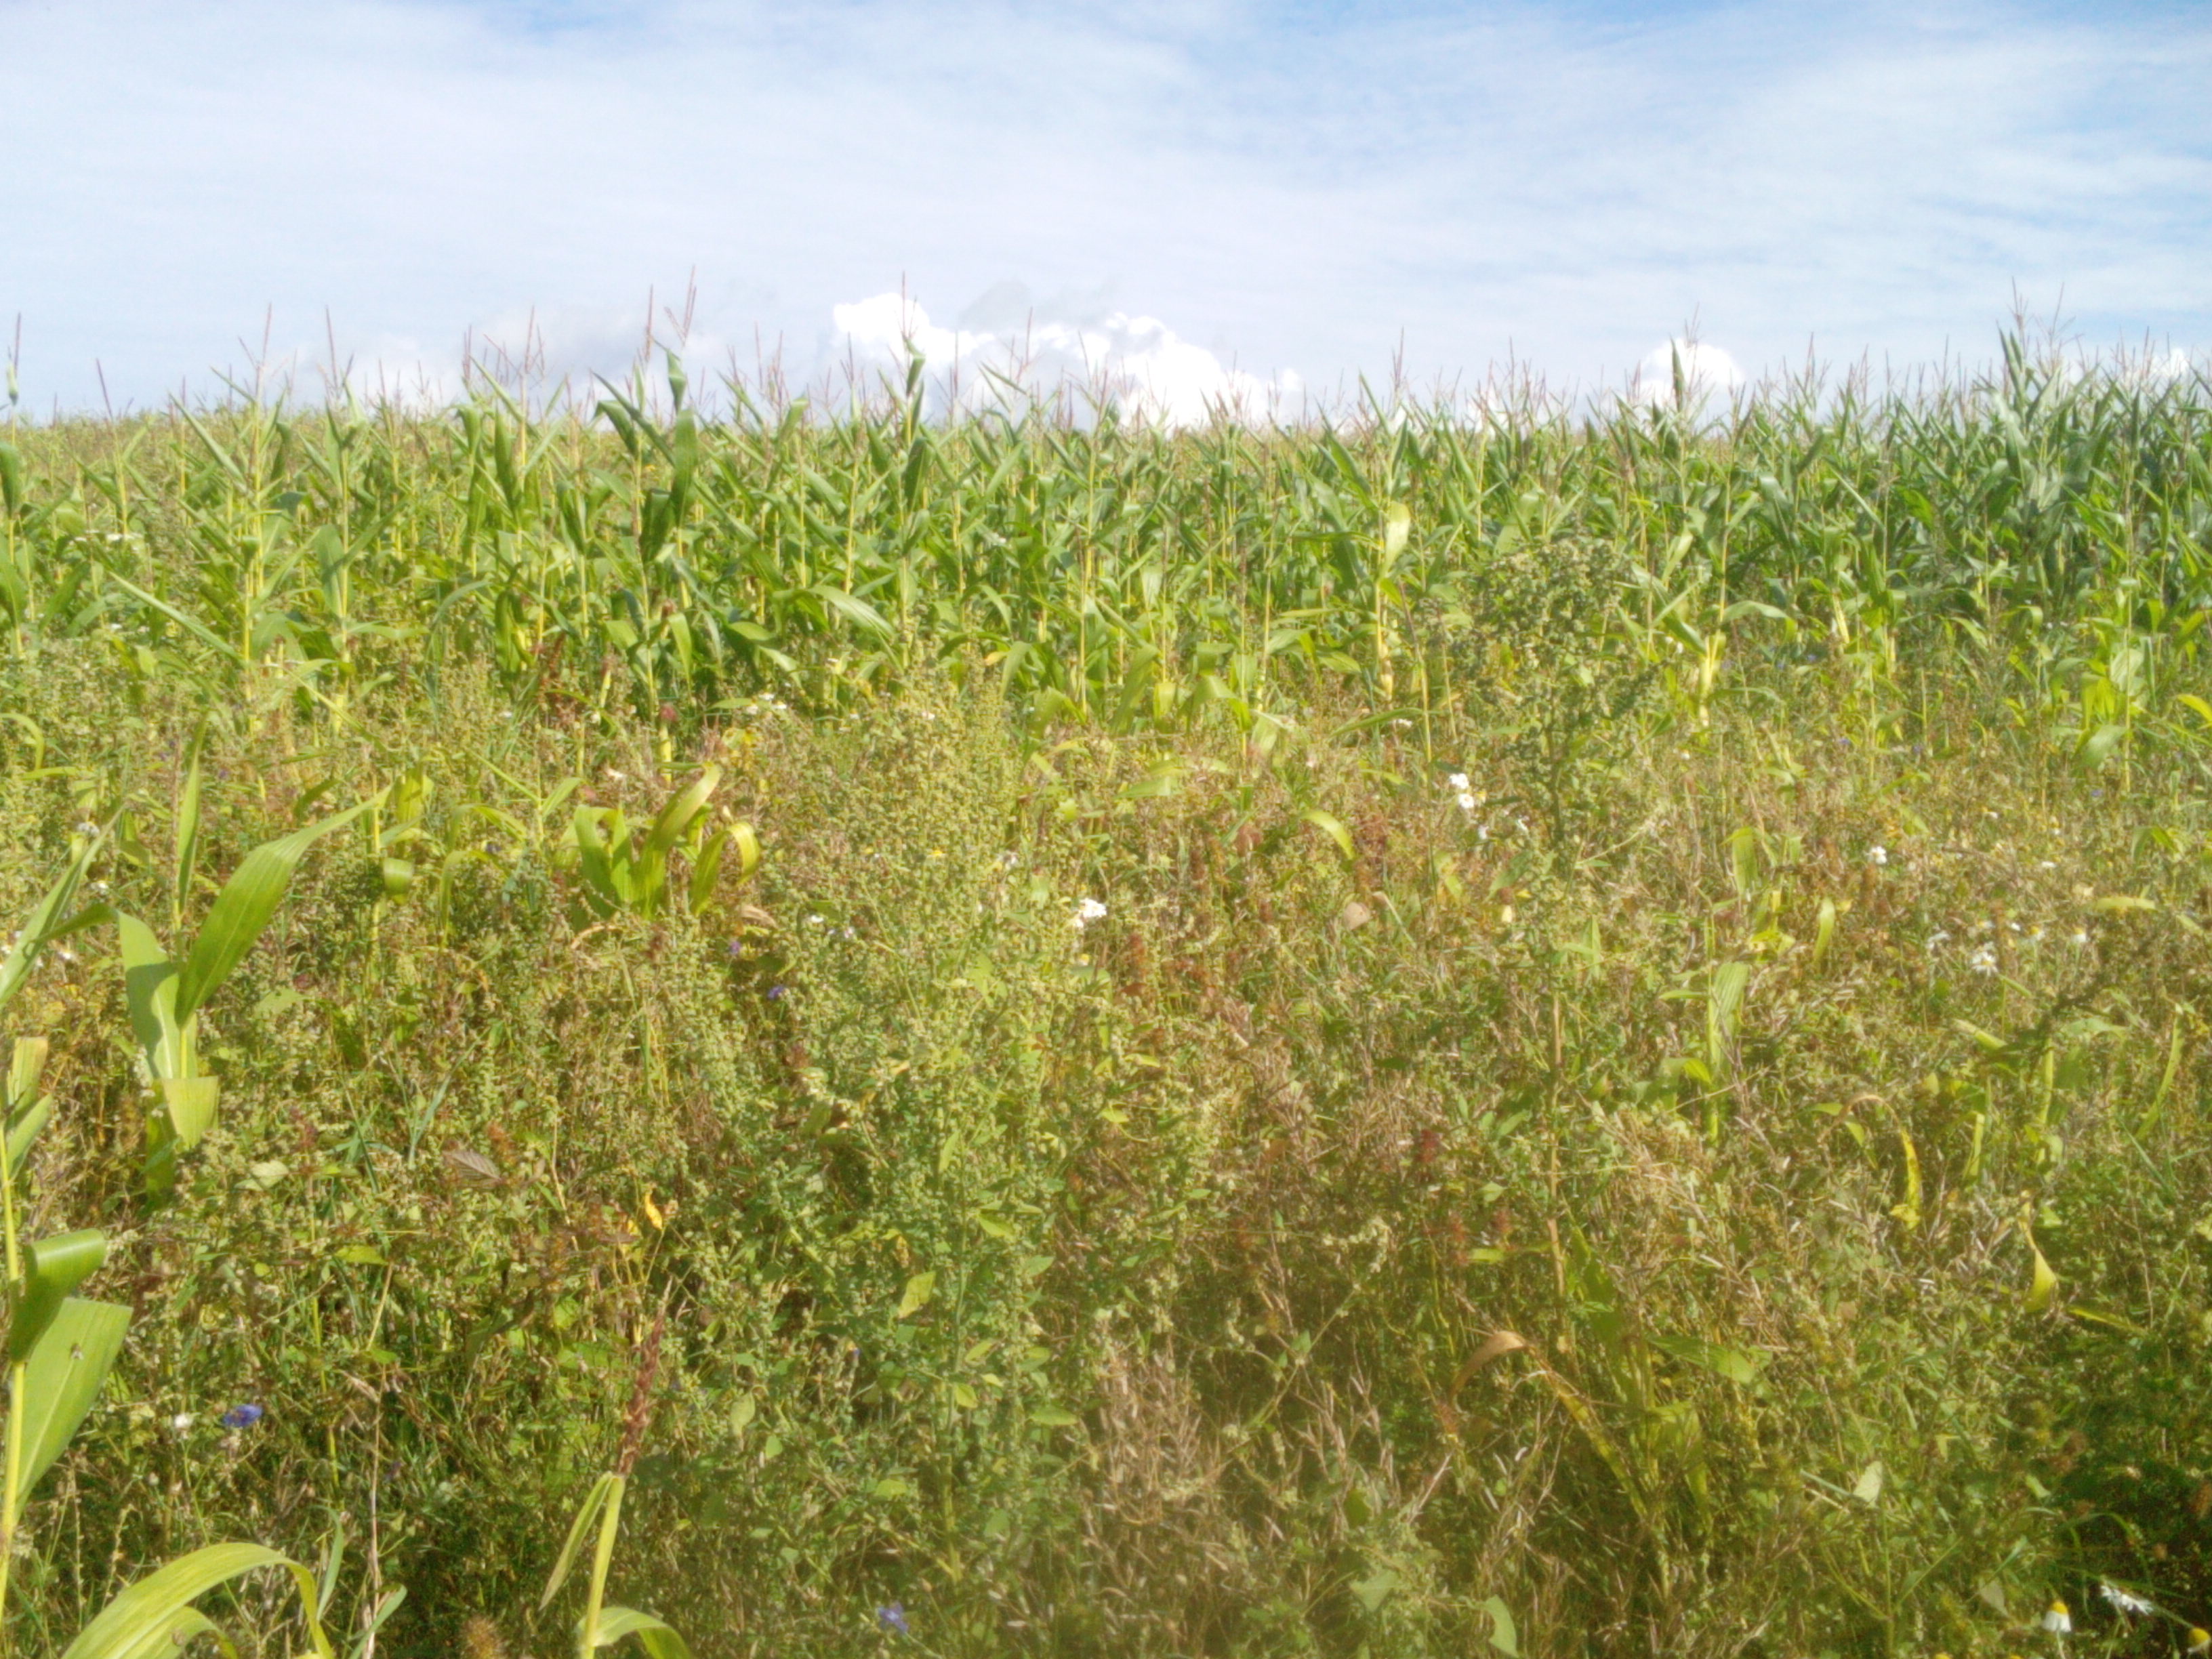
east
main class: Cropland
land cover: Maize
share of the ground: > 75 %
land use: Agriculture (excluding fallow land and kitchen gardens)
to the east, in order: Maize; Other bare soil; Common wheat; Grassland without tree/shrub cover; Dry pulses
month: September
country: LT
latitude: 55.7937
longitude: 22.4846
